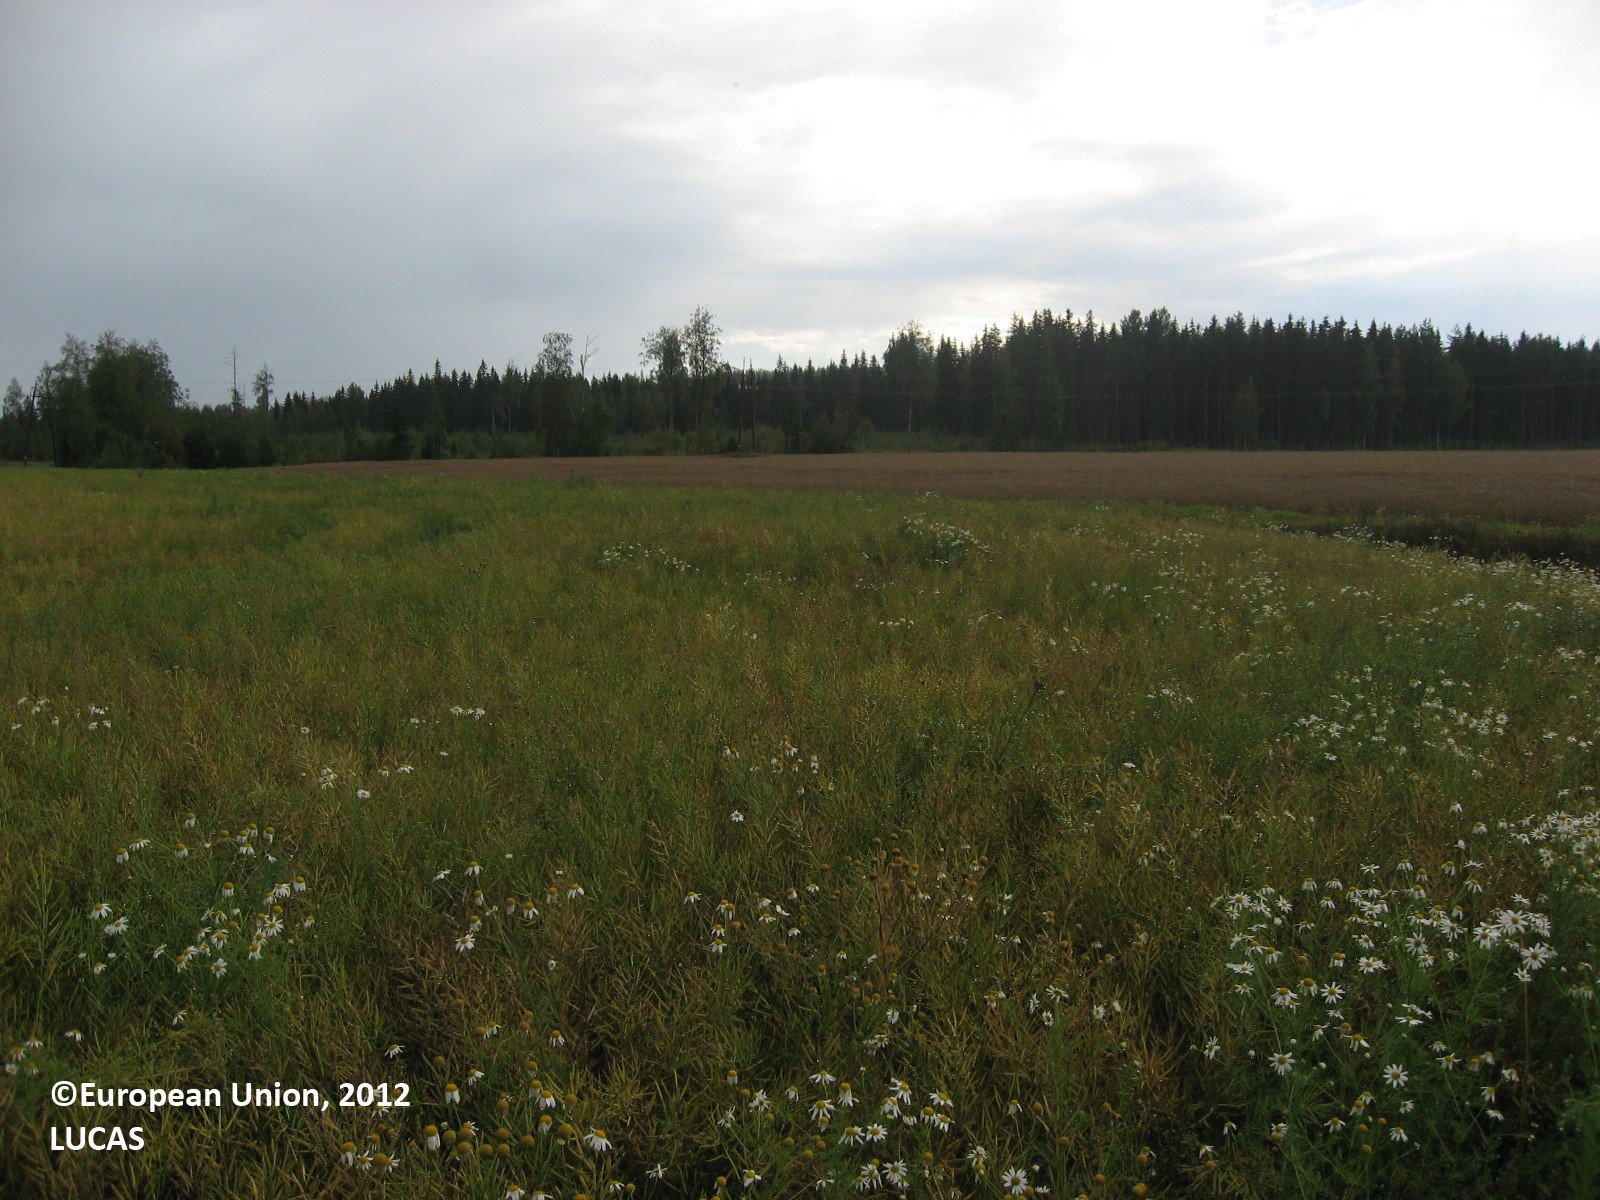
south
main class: Cropland
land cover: Rape and turnip rape
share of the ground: > 75 %
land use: Agriculture (excluding fallow land and kitchen gardens)
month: August
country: FI
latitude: 60.7570
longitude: 25.1107
